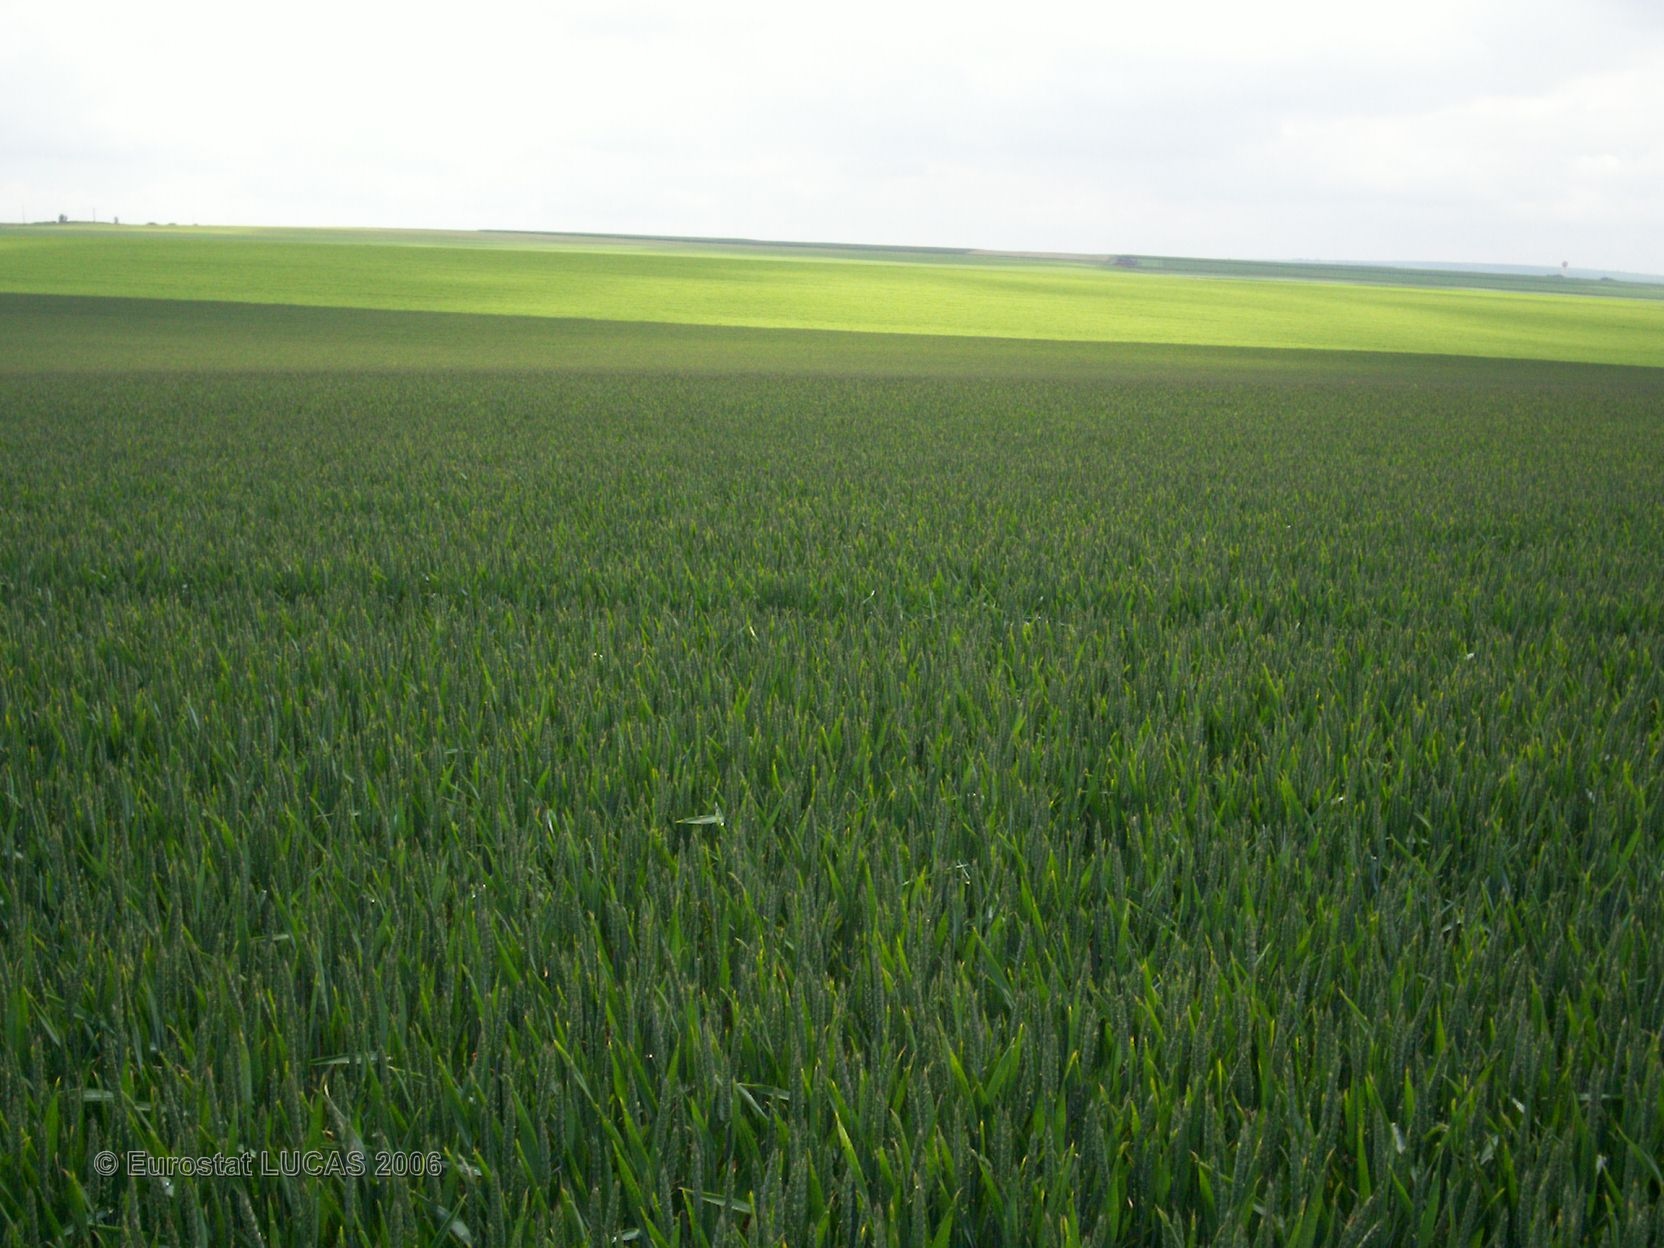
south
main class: Cropland
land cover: Common wheat
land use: Agriculture (excluding fallow land and kitchen gardens)
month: June
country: FR
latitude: 48.6054
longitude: 4.4230
